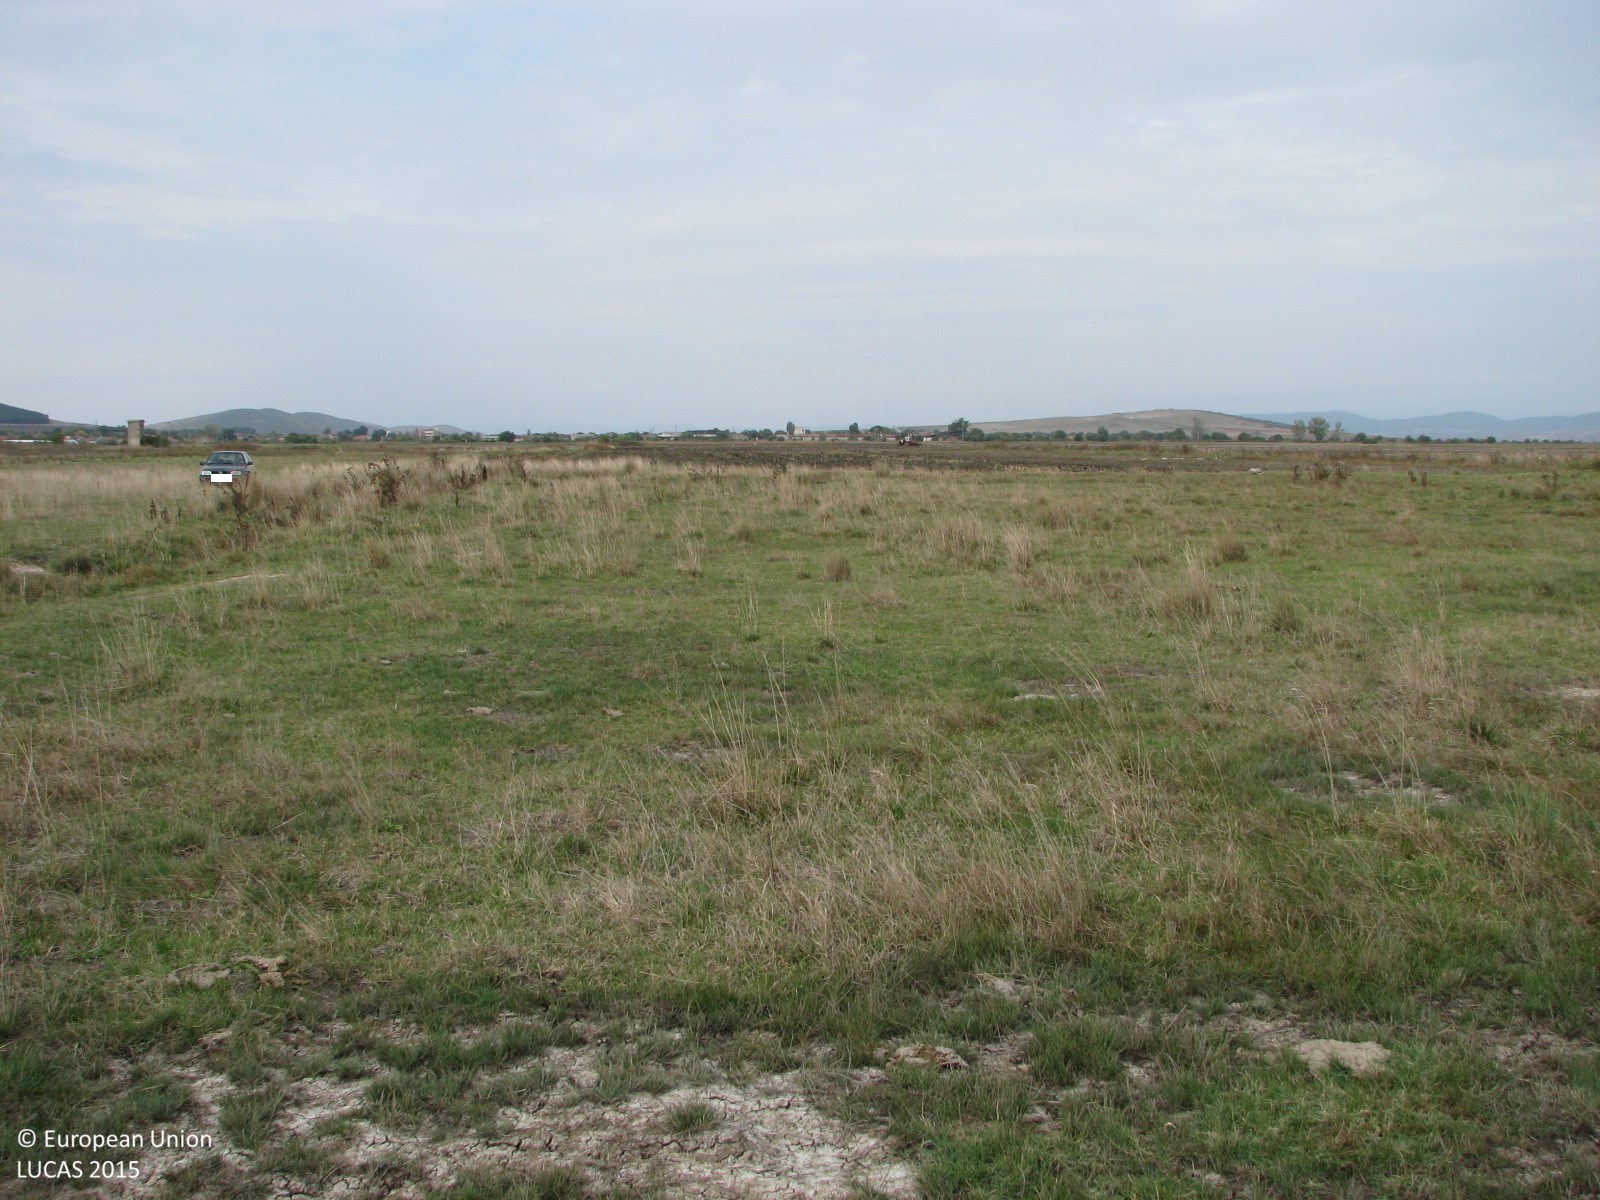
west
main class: Grassland
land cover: Grassland without tree/shrub cover
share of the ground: > 75 %
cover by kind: herbaceous plants 95 %, unconsolidated bare surface 5 %
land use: Agriculture (excluding fallow land and kitchen gardens)
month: October
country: BG
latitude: 42.5024
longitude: 26.2842
